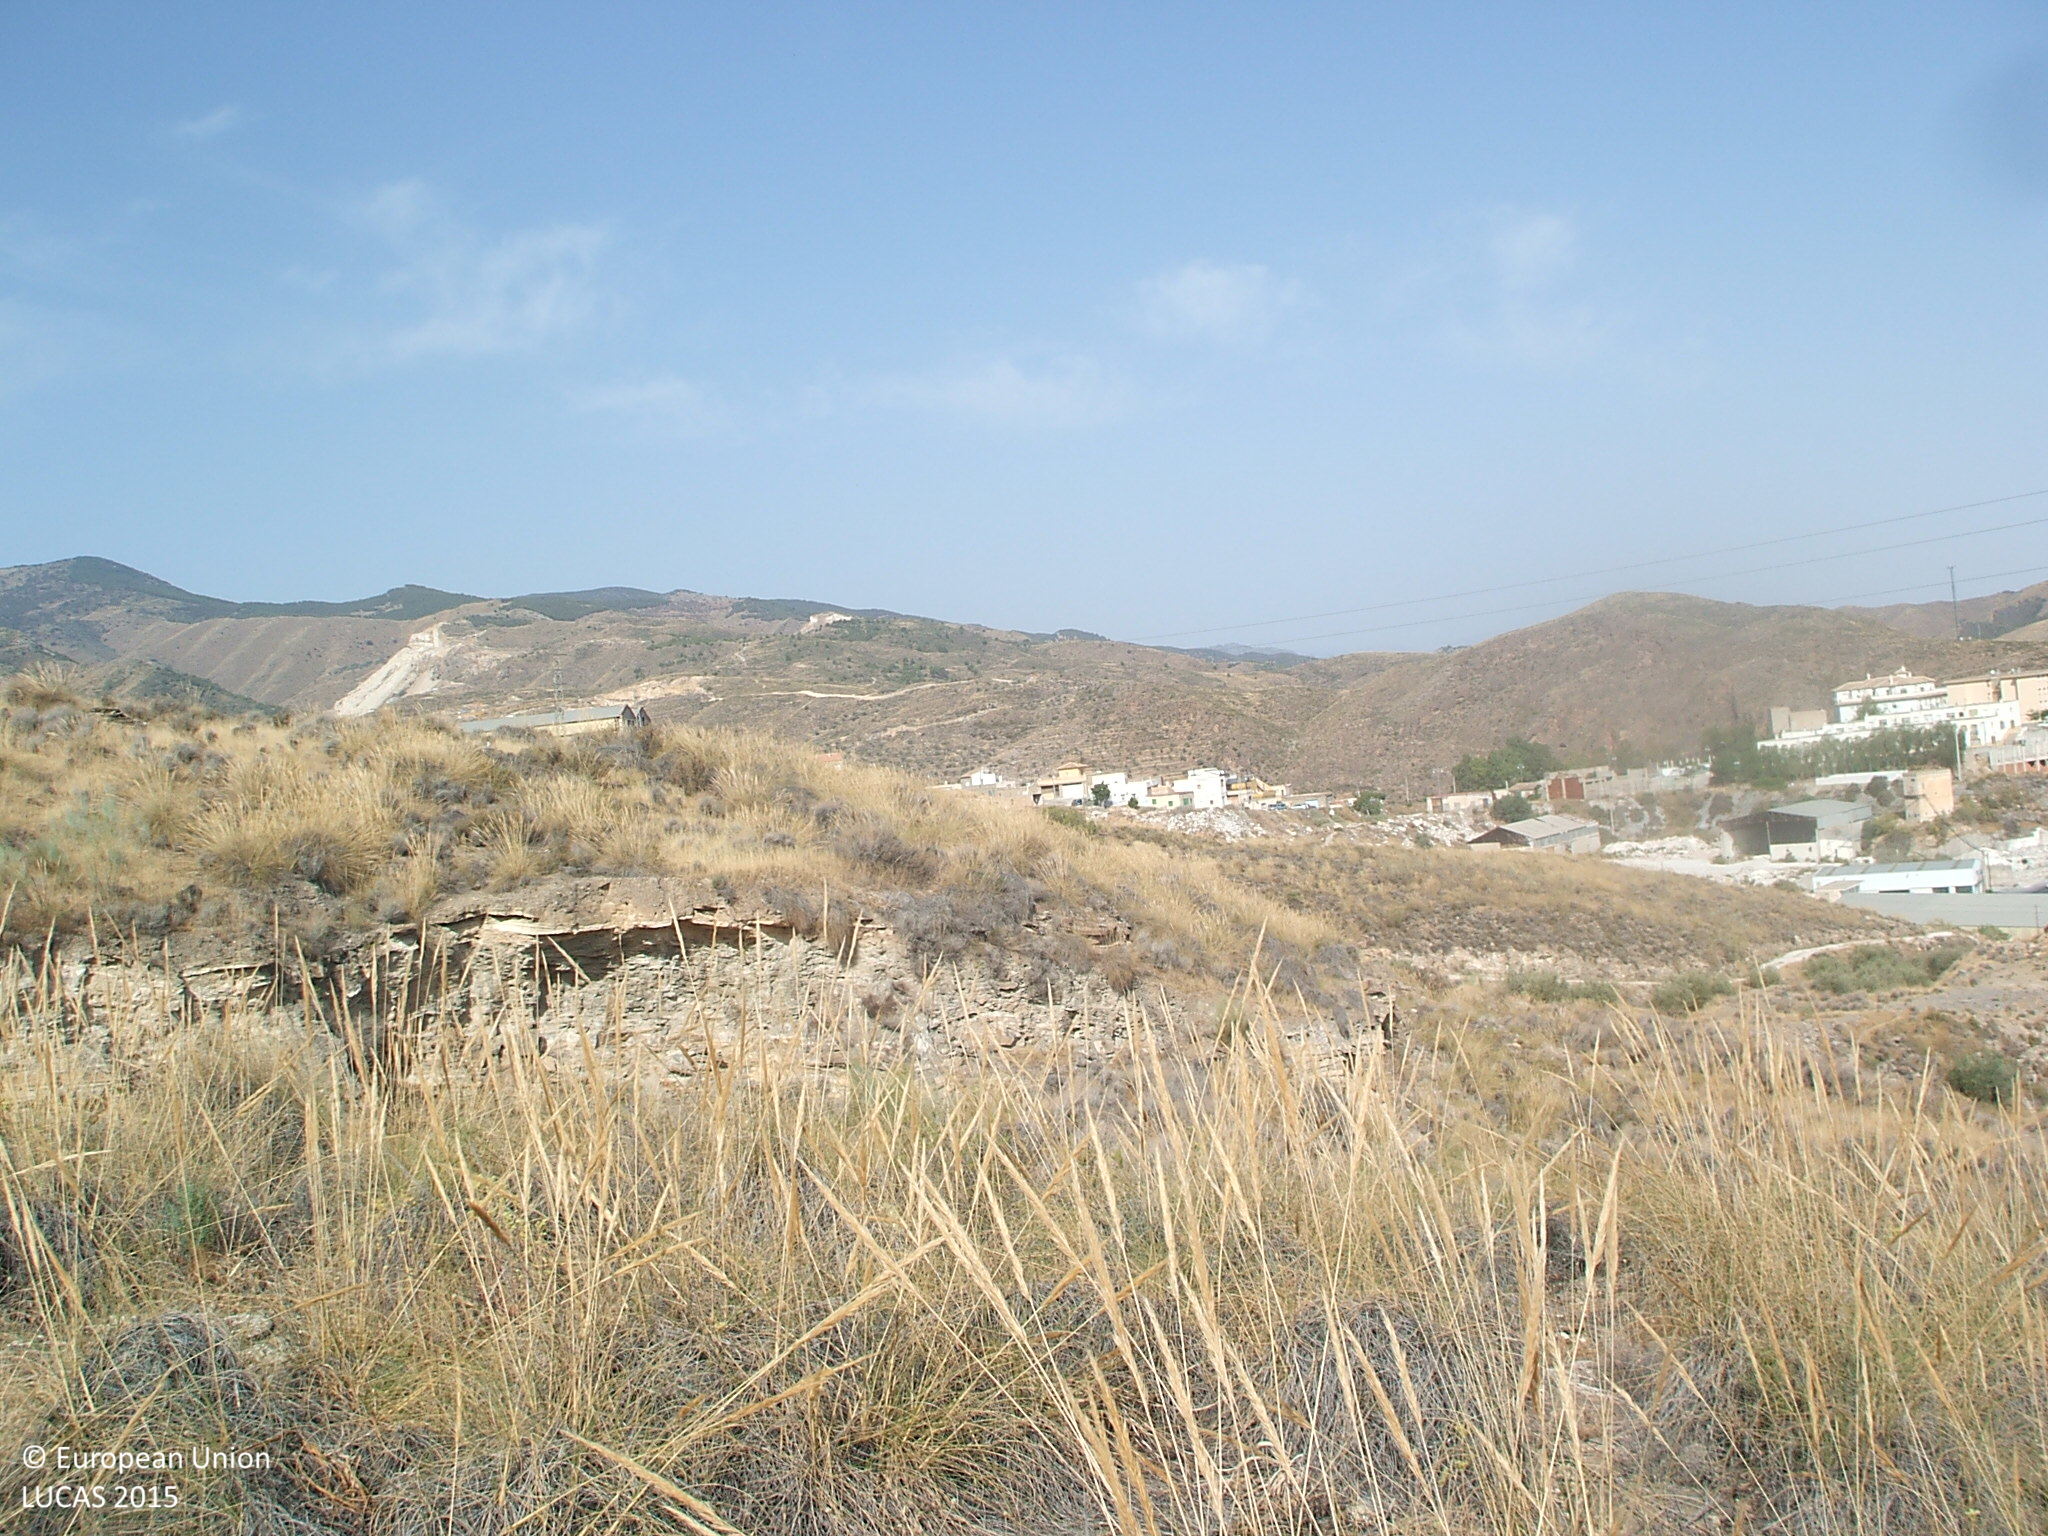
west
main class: Grassland
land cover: Grassland without tree/shrub cover
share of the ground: > 75 %
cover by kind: herbaceous plants 75 %, consolidated bare surface 20 %, shrubs 5 %
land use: Semi-natural and natural areas not in use
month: July
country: ES
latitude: 37.3313
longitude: -2.2946
